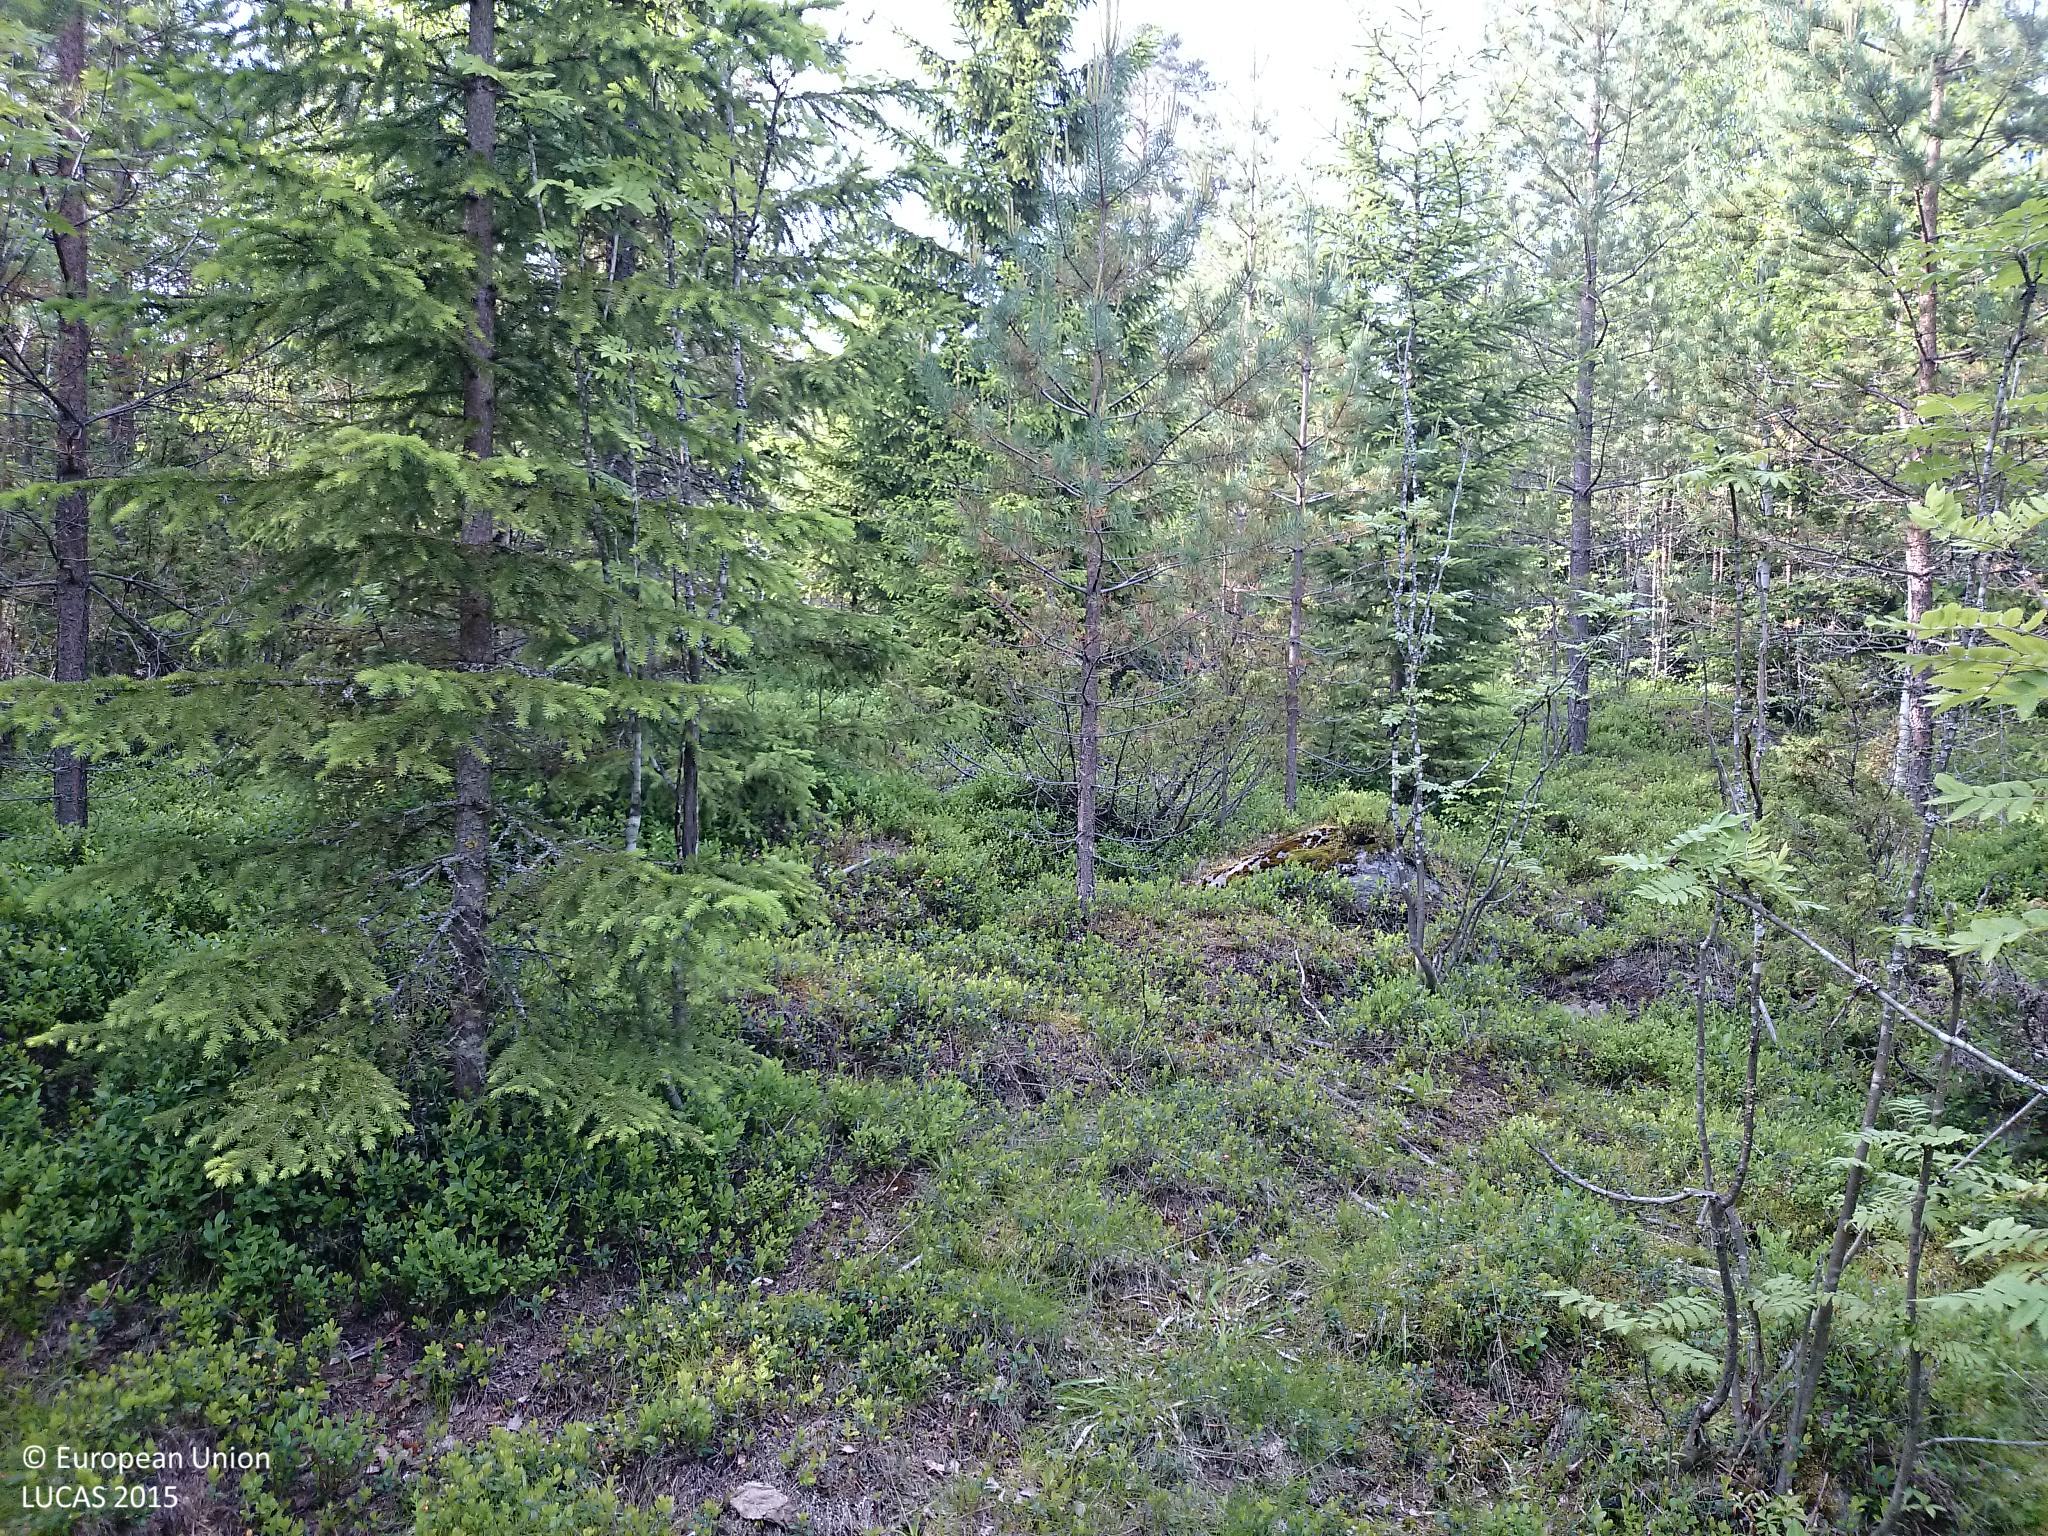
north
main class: Woodland
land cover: Other mixed woodland
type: boreal forest
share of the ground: 50 - 75 %
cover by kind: coniferous forest trees 45 %, shrubs 25 %, broadleaved forest trees 15 %, herbaceous plants 15 %
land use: Forestry
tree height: > 5 m
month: June
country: SE
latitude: 64.1910
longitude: 20.8316
